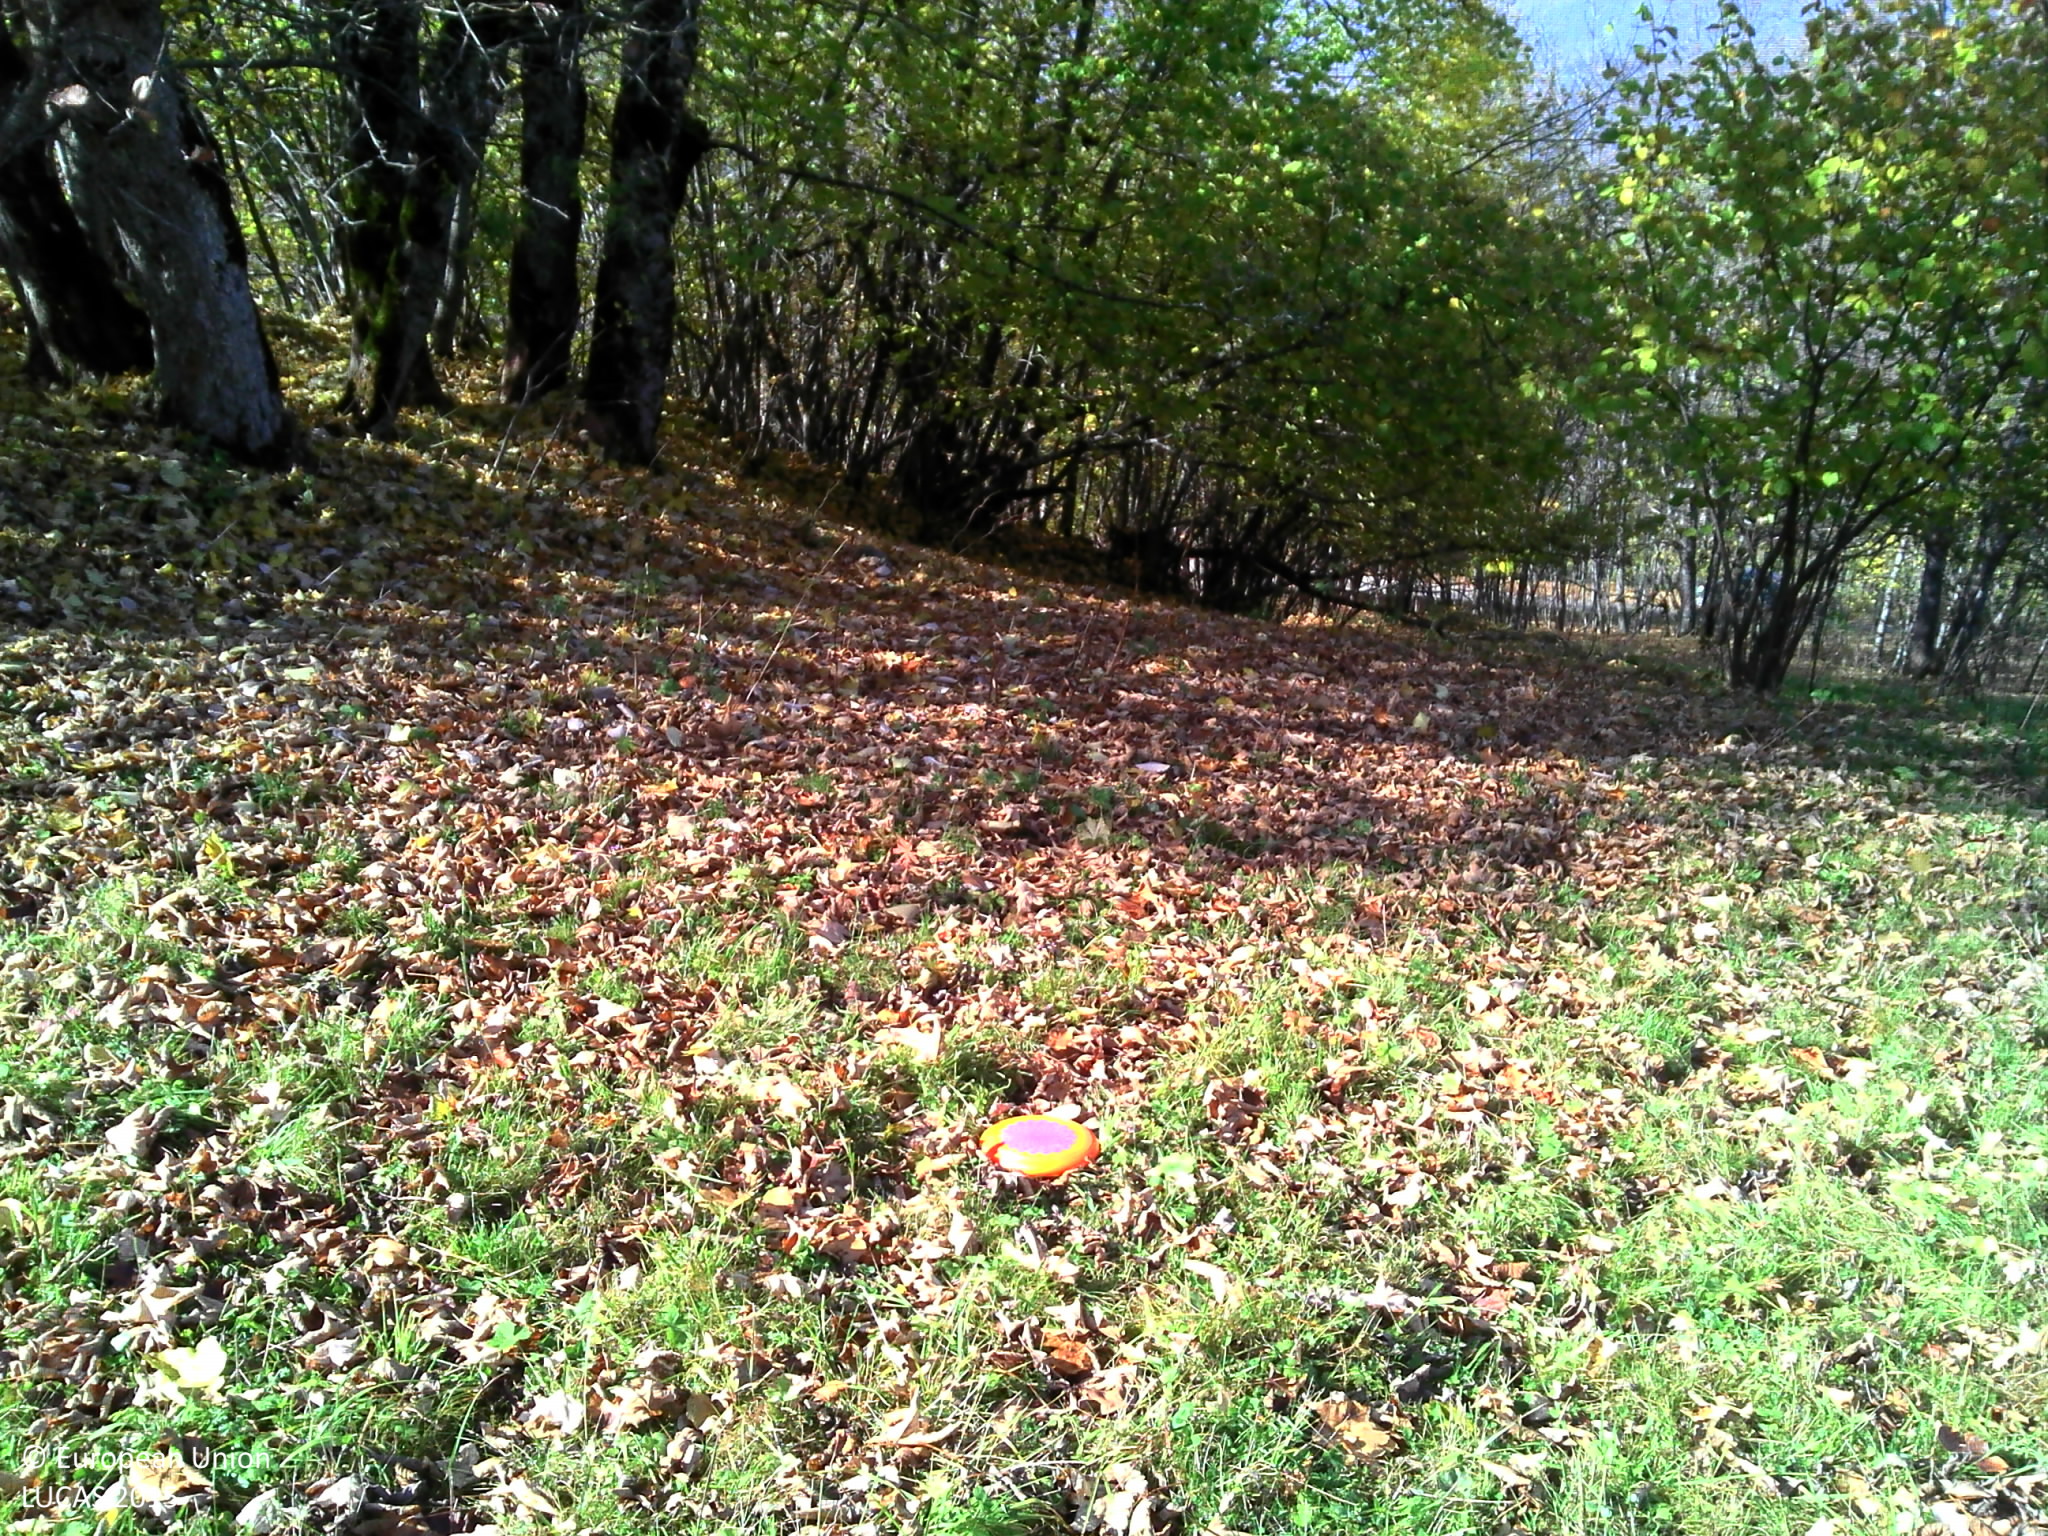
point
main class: Woodland
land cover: Broadleaved woodland
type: mesophytic deciduous forest
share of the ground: 25 - 50 %
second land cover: Grassland without tree/shrub cover
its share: > 75 %
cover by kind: herbaceous plants 70 %, broadleaved forest trees 30 %
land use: Forestry
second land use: Agriculture (excluding fallow land and kitchen gardens)
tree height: > 5 m
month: October
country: FR
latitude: 45.3697
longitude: 6.3659
